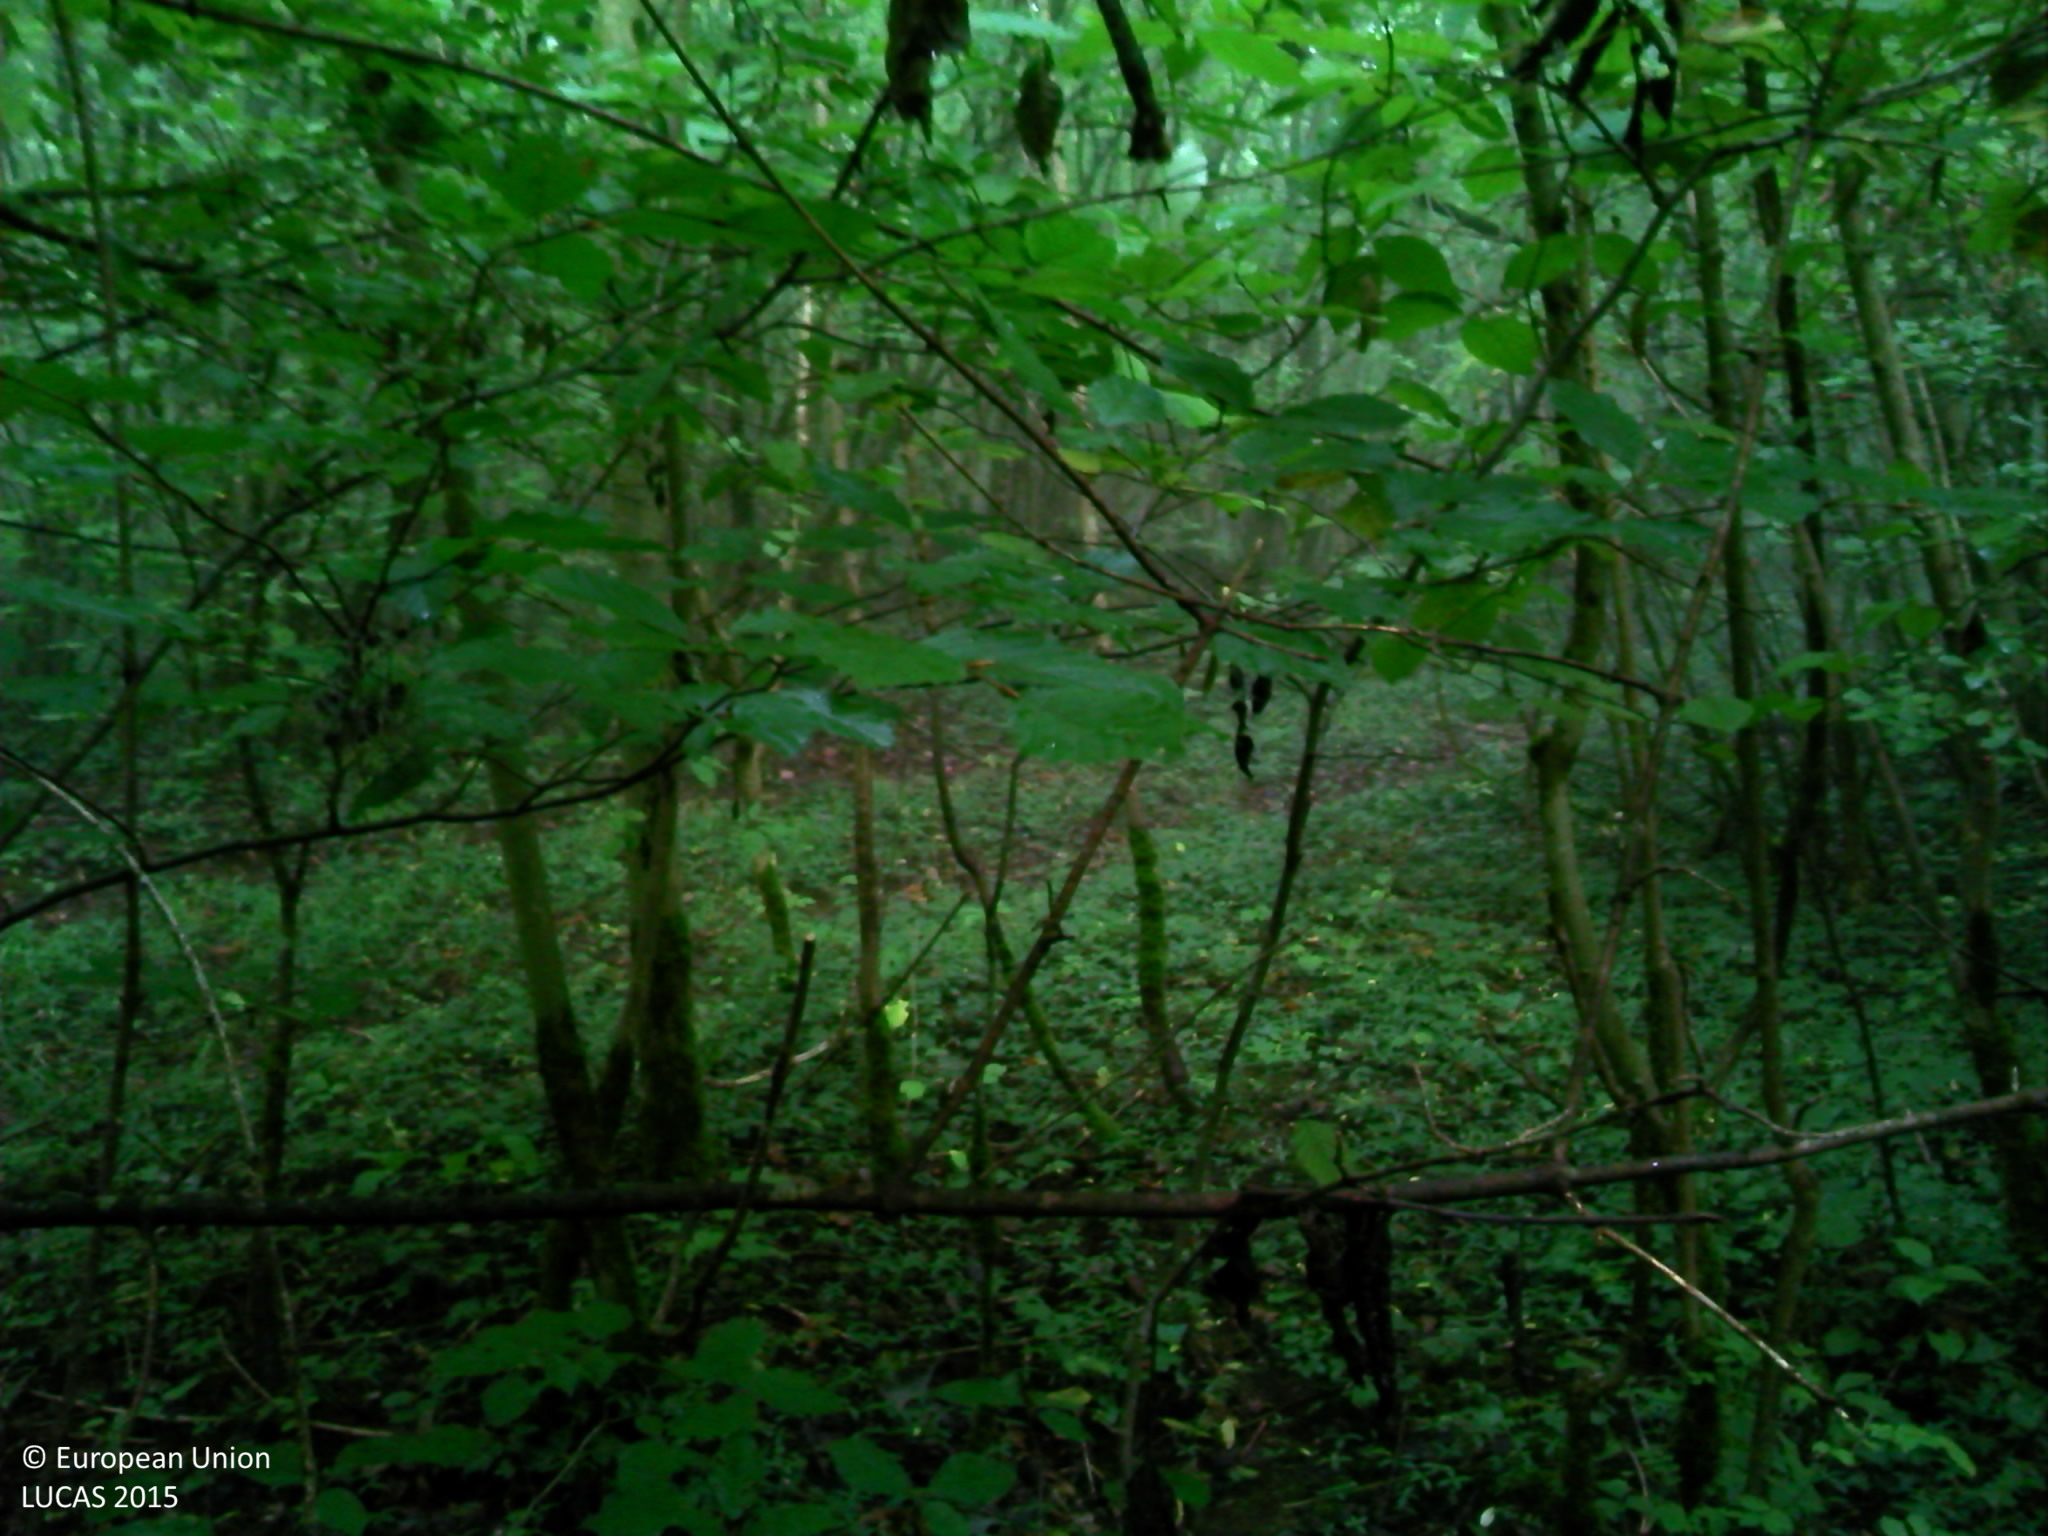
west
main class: Woodland
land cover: Broadleaved woodland
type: mesophytic deciduous forest
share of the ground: > 75 %
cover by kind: broadleaved forest trees 90 %, herbaceous plants 5 %, consolidated bare surface 5 %
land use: Forestry
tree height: > 5 m
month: September
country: FR
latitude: 49.2508
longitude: 6.0291
